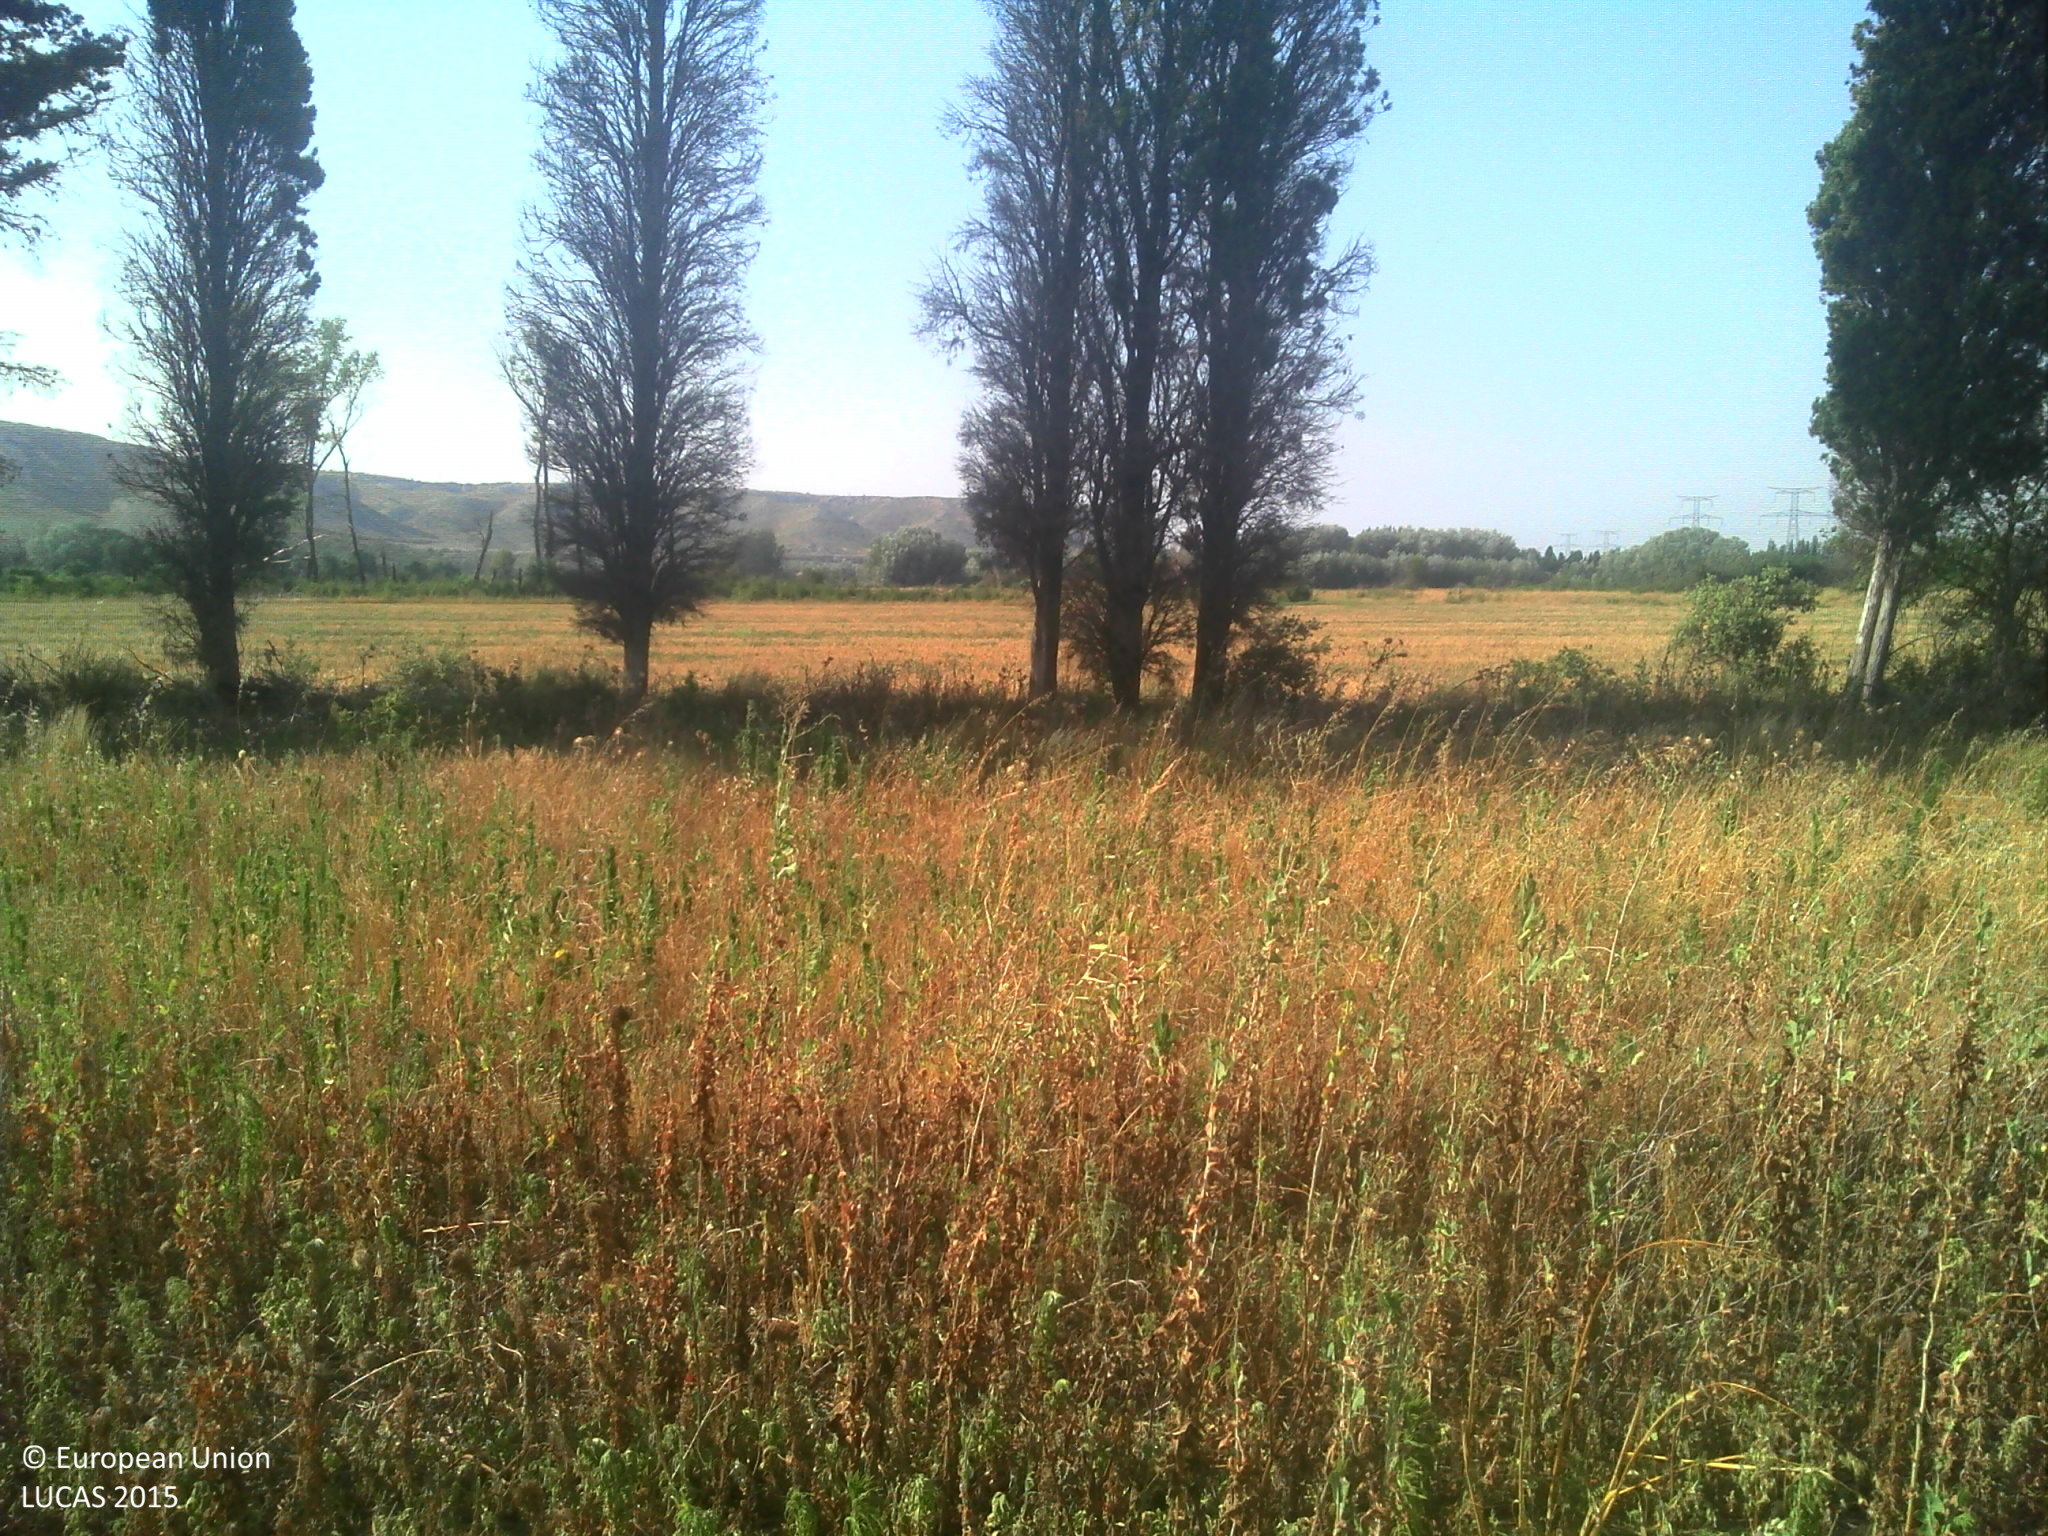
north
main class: Grassland
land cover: Spontaneously vegetated surfaces
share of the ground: > 75 %
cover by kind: herbaceous plants 100 %
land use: Fallow land
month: July
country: FR
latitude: 43.7268
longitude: 5.0560
